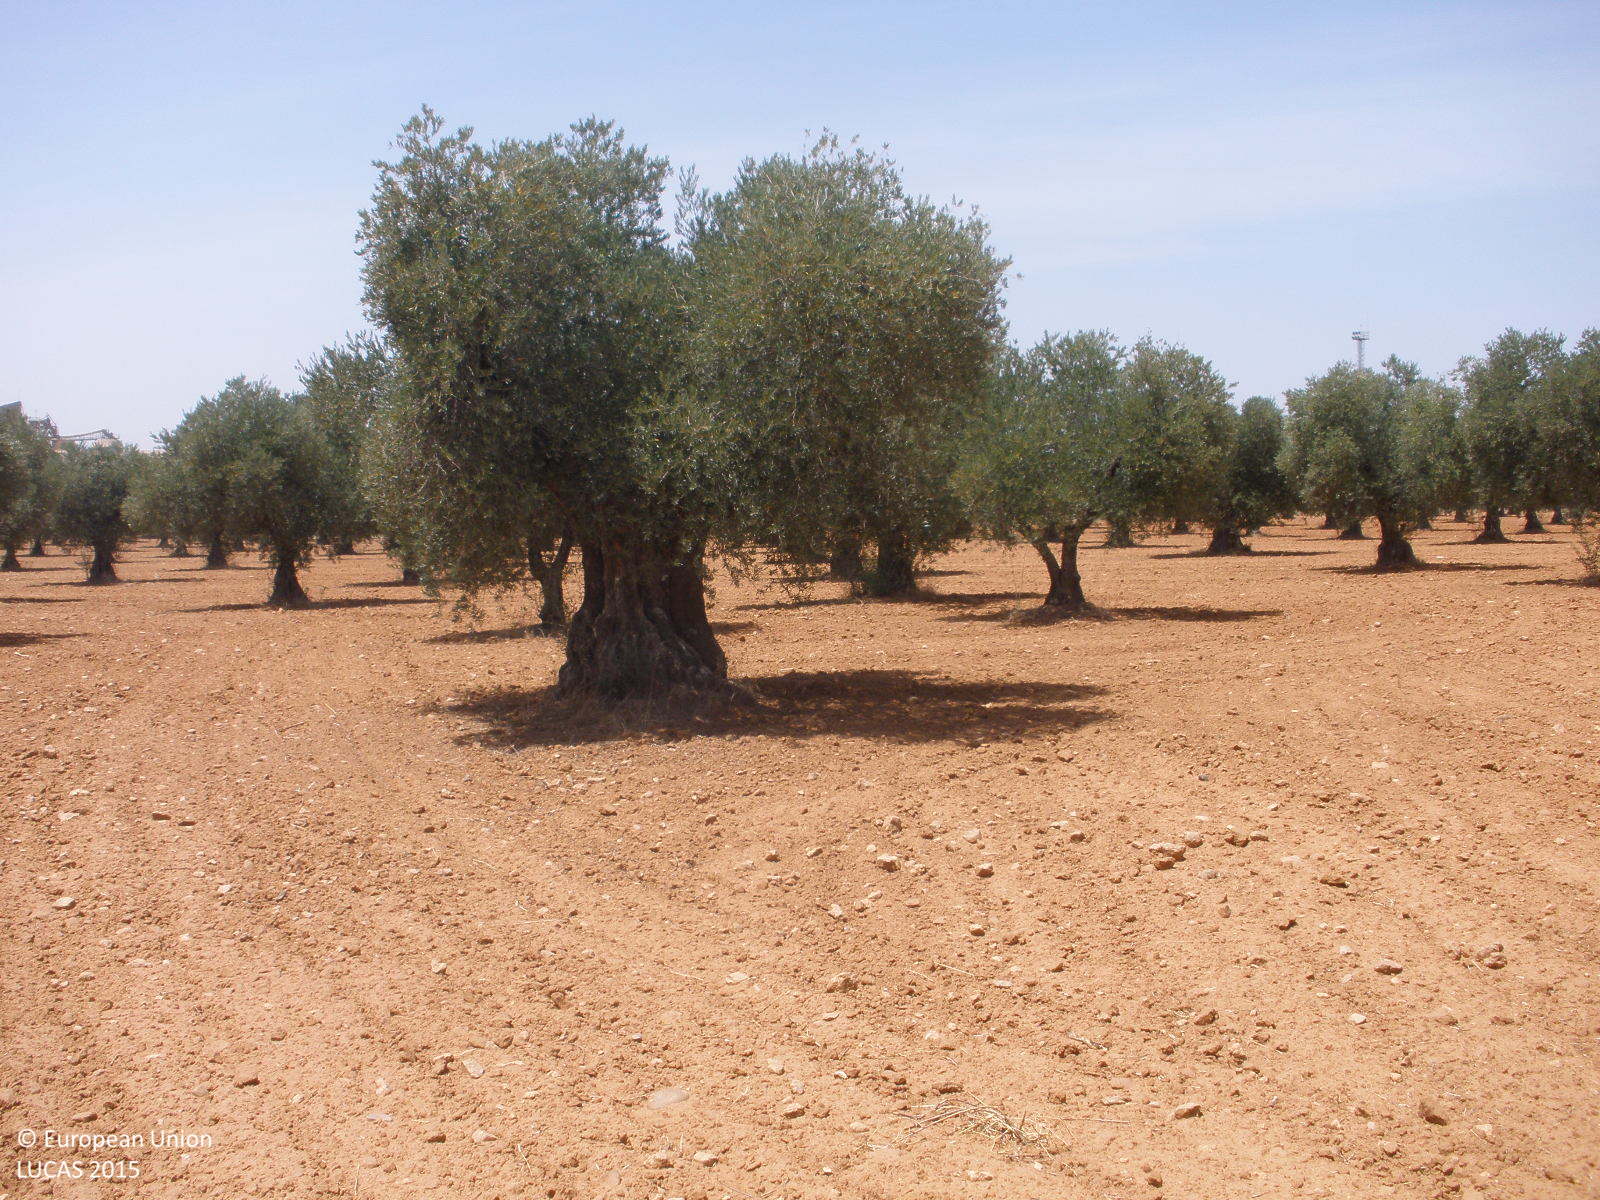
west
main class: Cropland
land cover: Olive groves
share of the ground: 25 - 50 %
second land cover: Other bare soil
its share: > 75 %
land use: Agriculture (excluding fallow land and kitchen gardens)
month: July
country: ES
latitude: 40.2494
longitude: -3.4696
